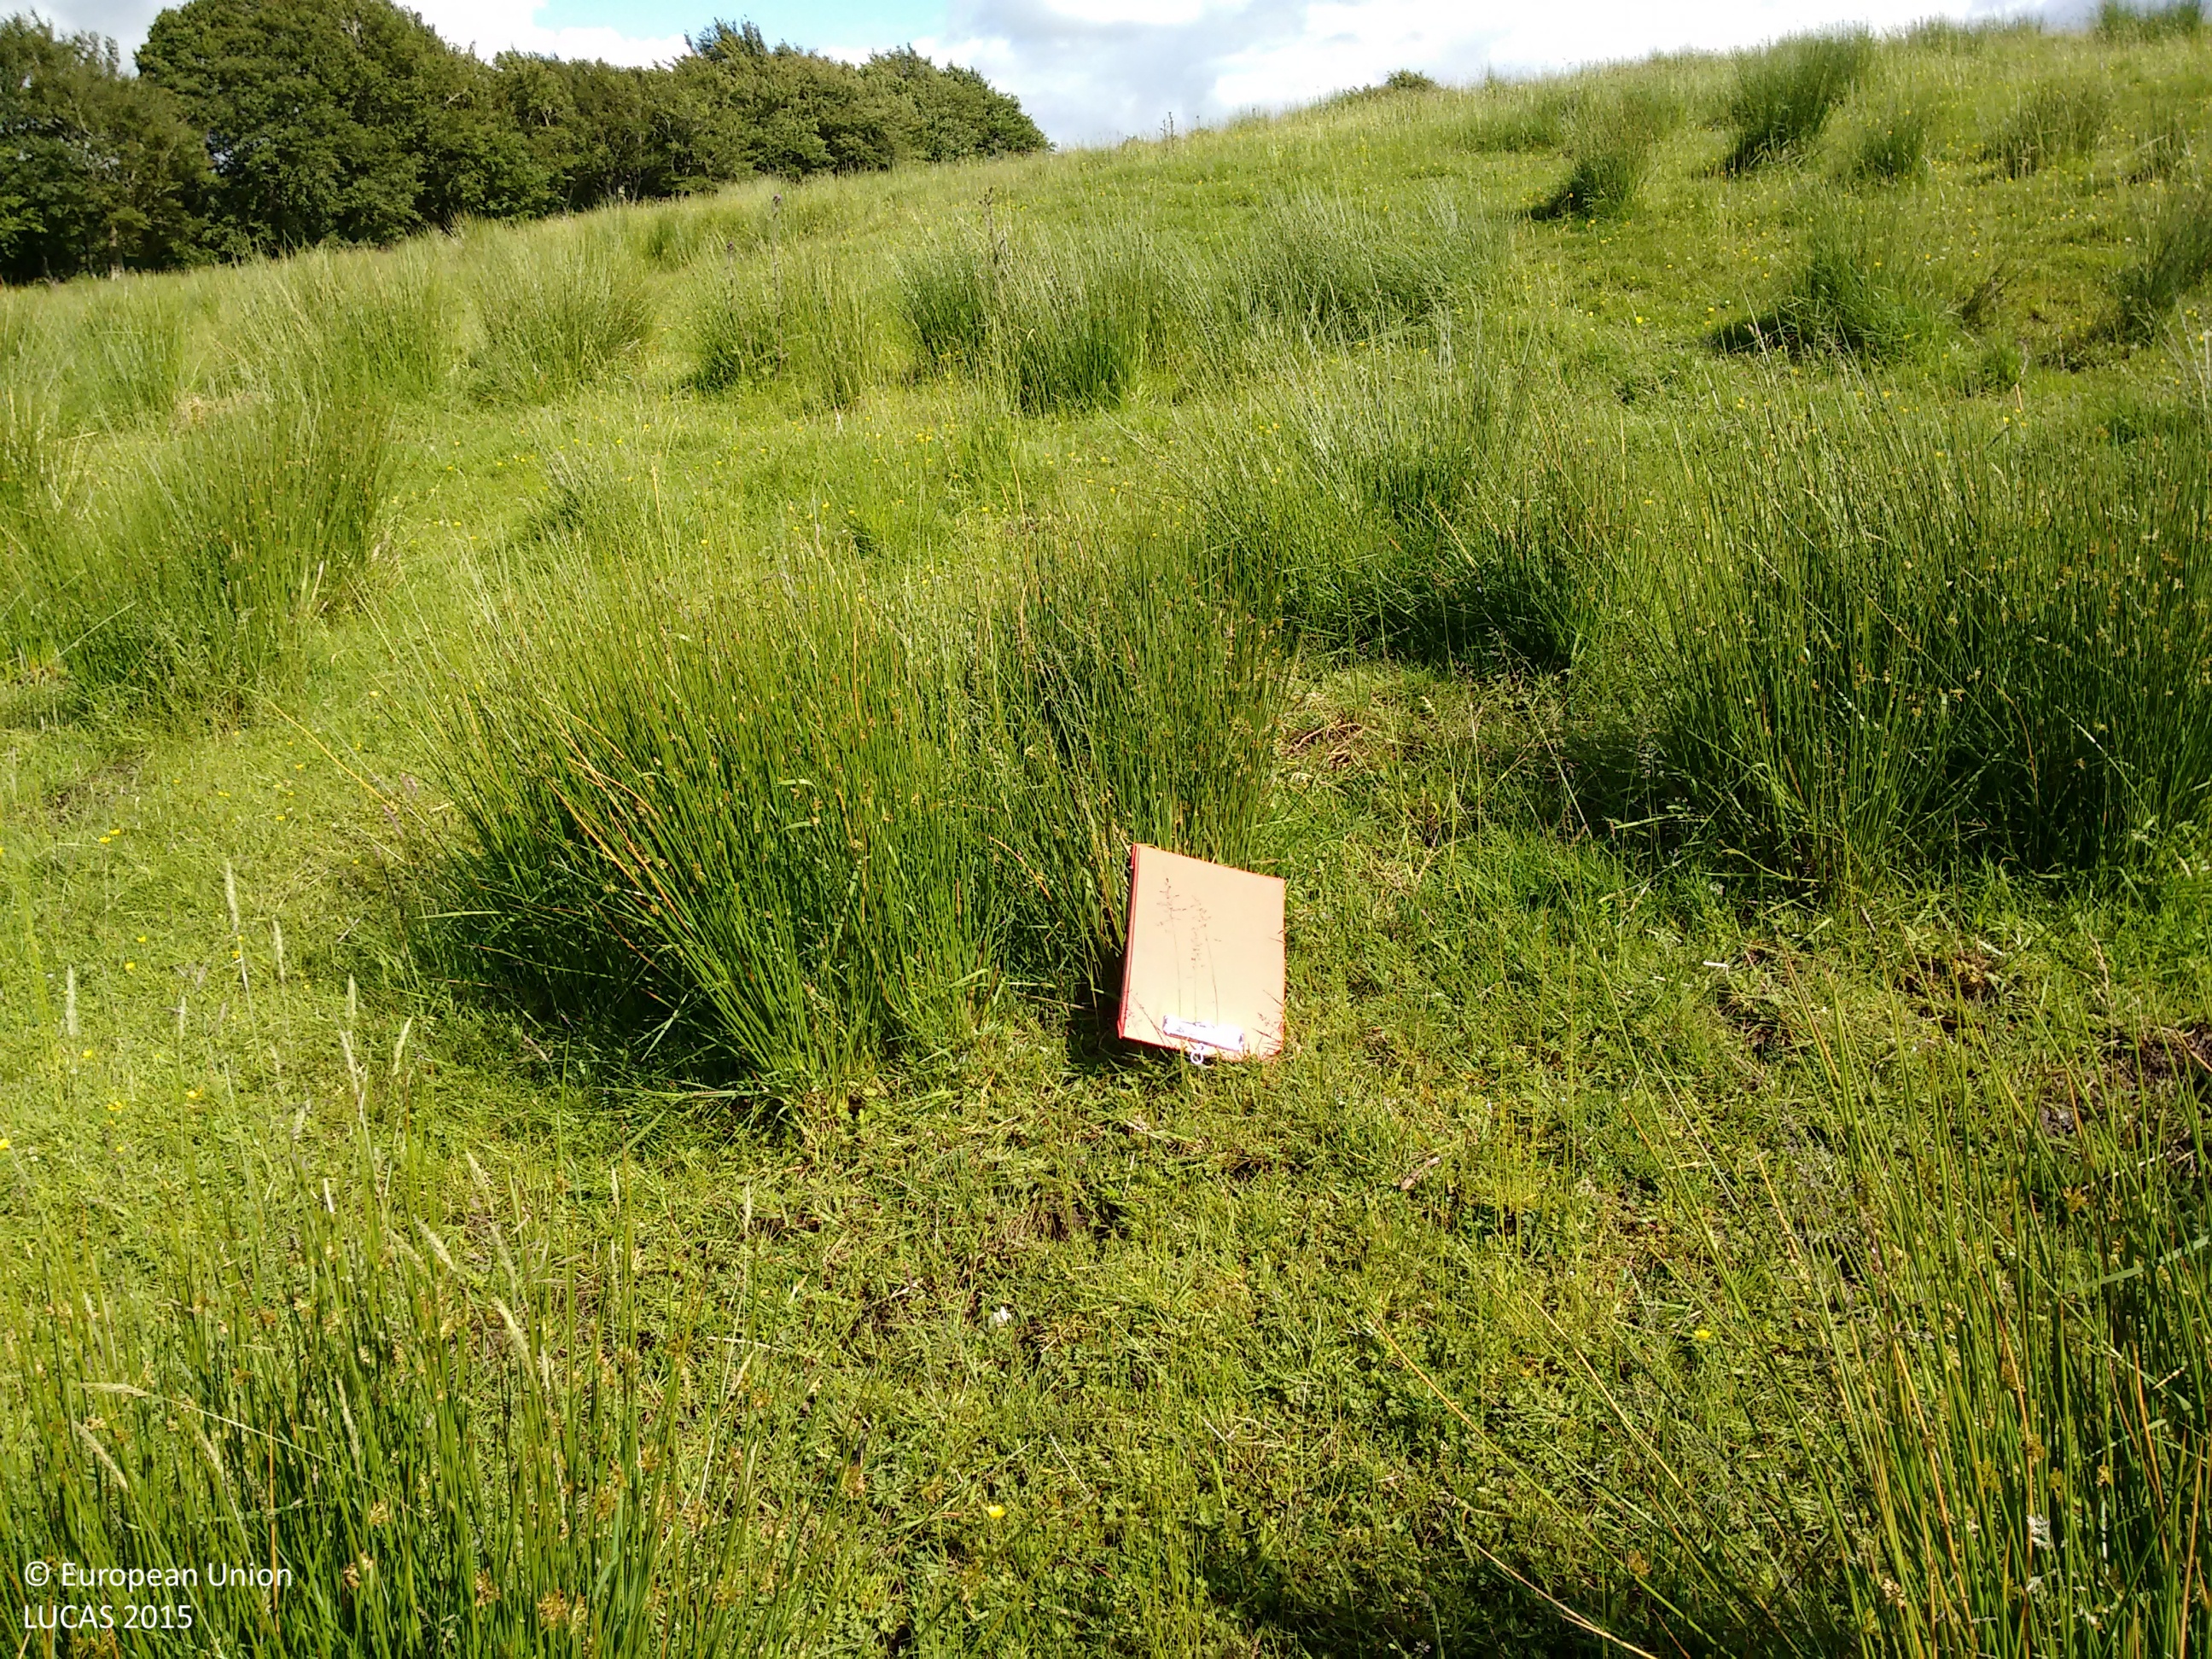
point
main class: Grassland
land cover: Grassland without tree/shrub cover
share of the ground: > 75 %
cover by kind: herbaceous plants 100 %
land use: Agriculture (excluding fallow land and kitchen gardens)
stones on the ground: < 10 %
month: July
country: GB
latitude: 55.6217
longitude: -4.1130
